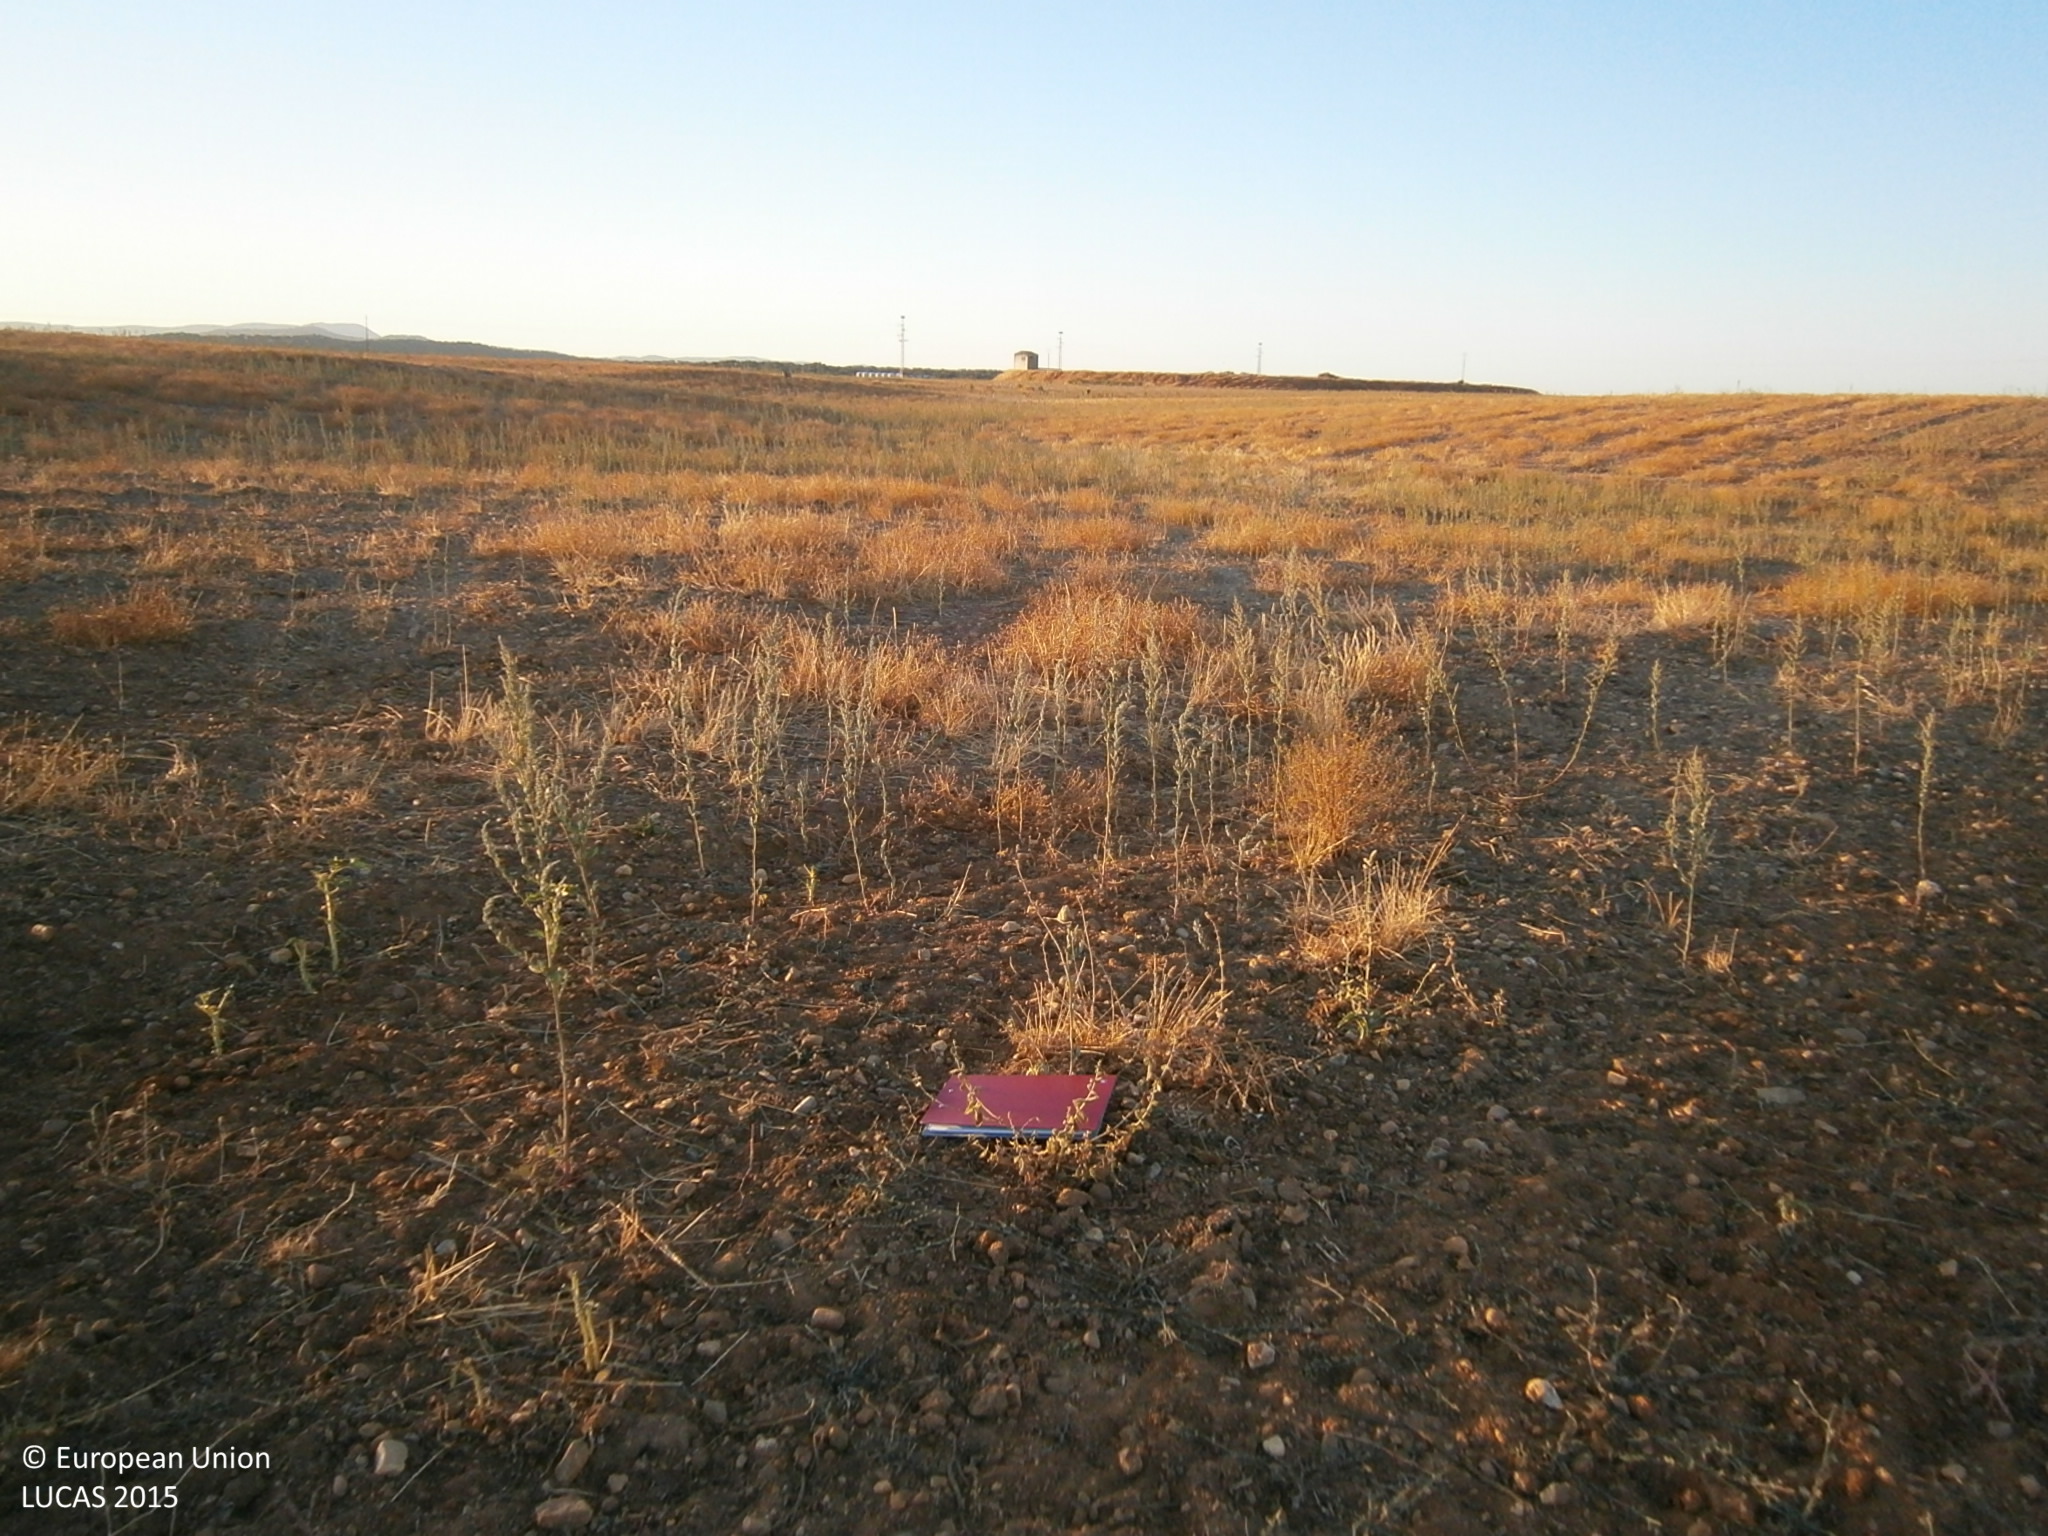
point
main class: Grassland
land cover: Spontaneously vegetated surfaces
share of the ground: > 75 %
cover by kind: herbaceous plants 80 %, unconsolidated bare surface 15 %
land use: Agriculture (excluding fallow land and kitchen gardens)
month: July
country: ES
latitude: 38.6782
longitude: -7.2100
